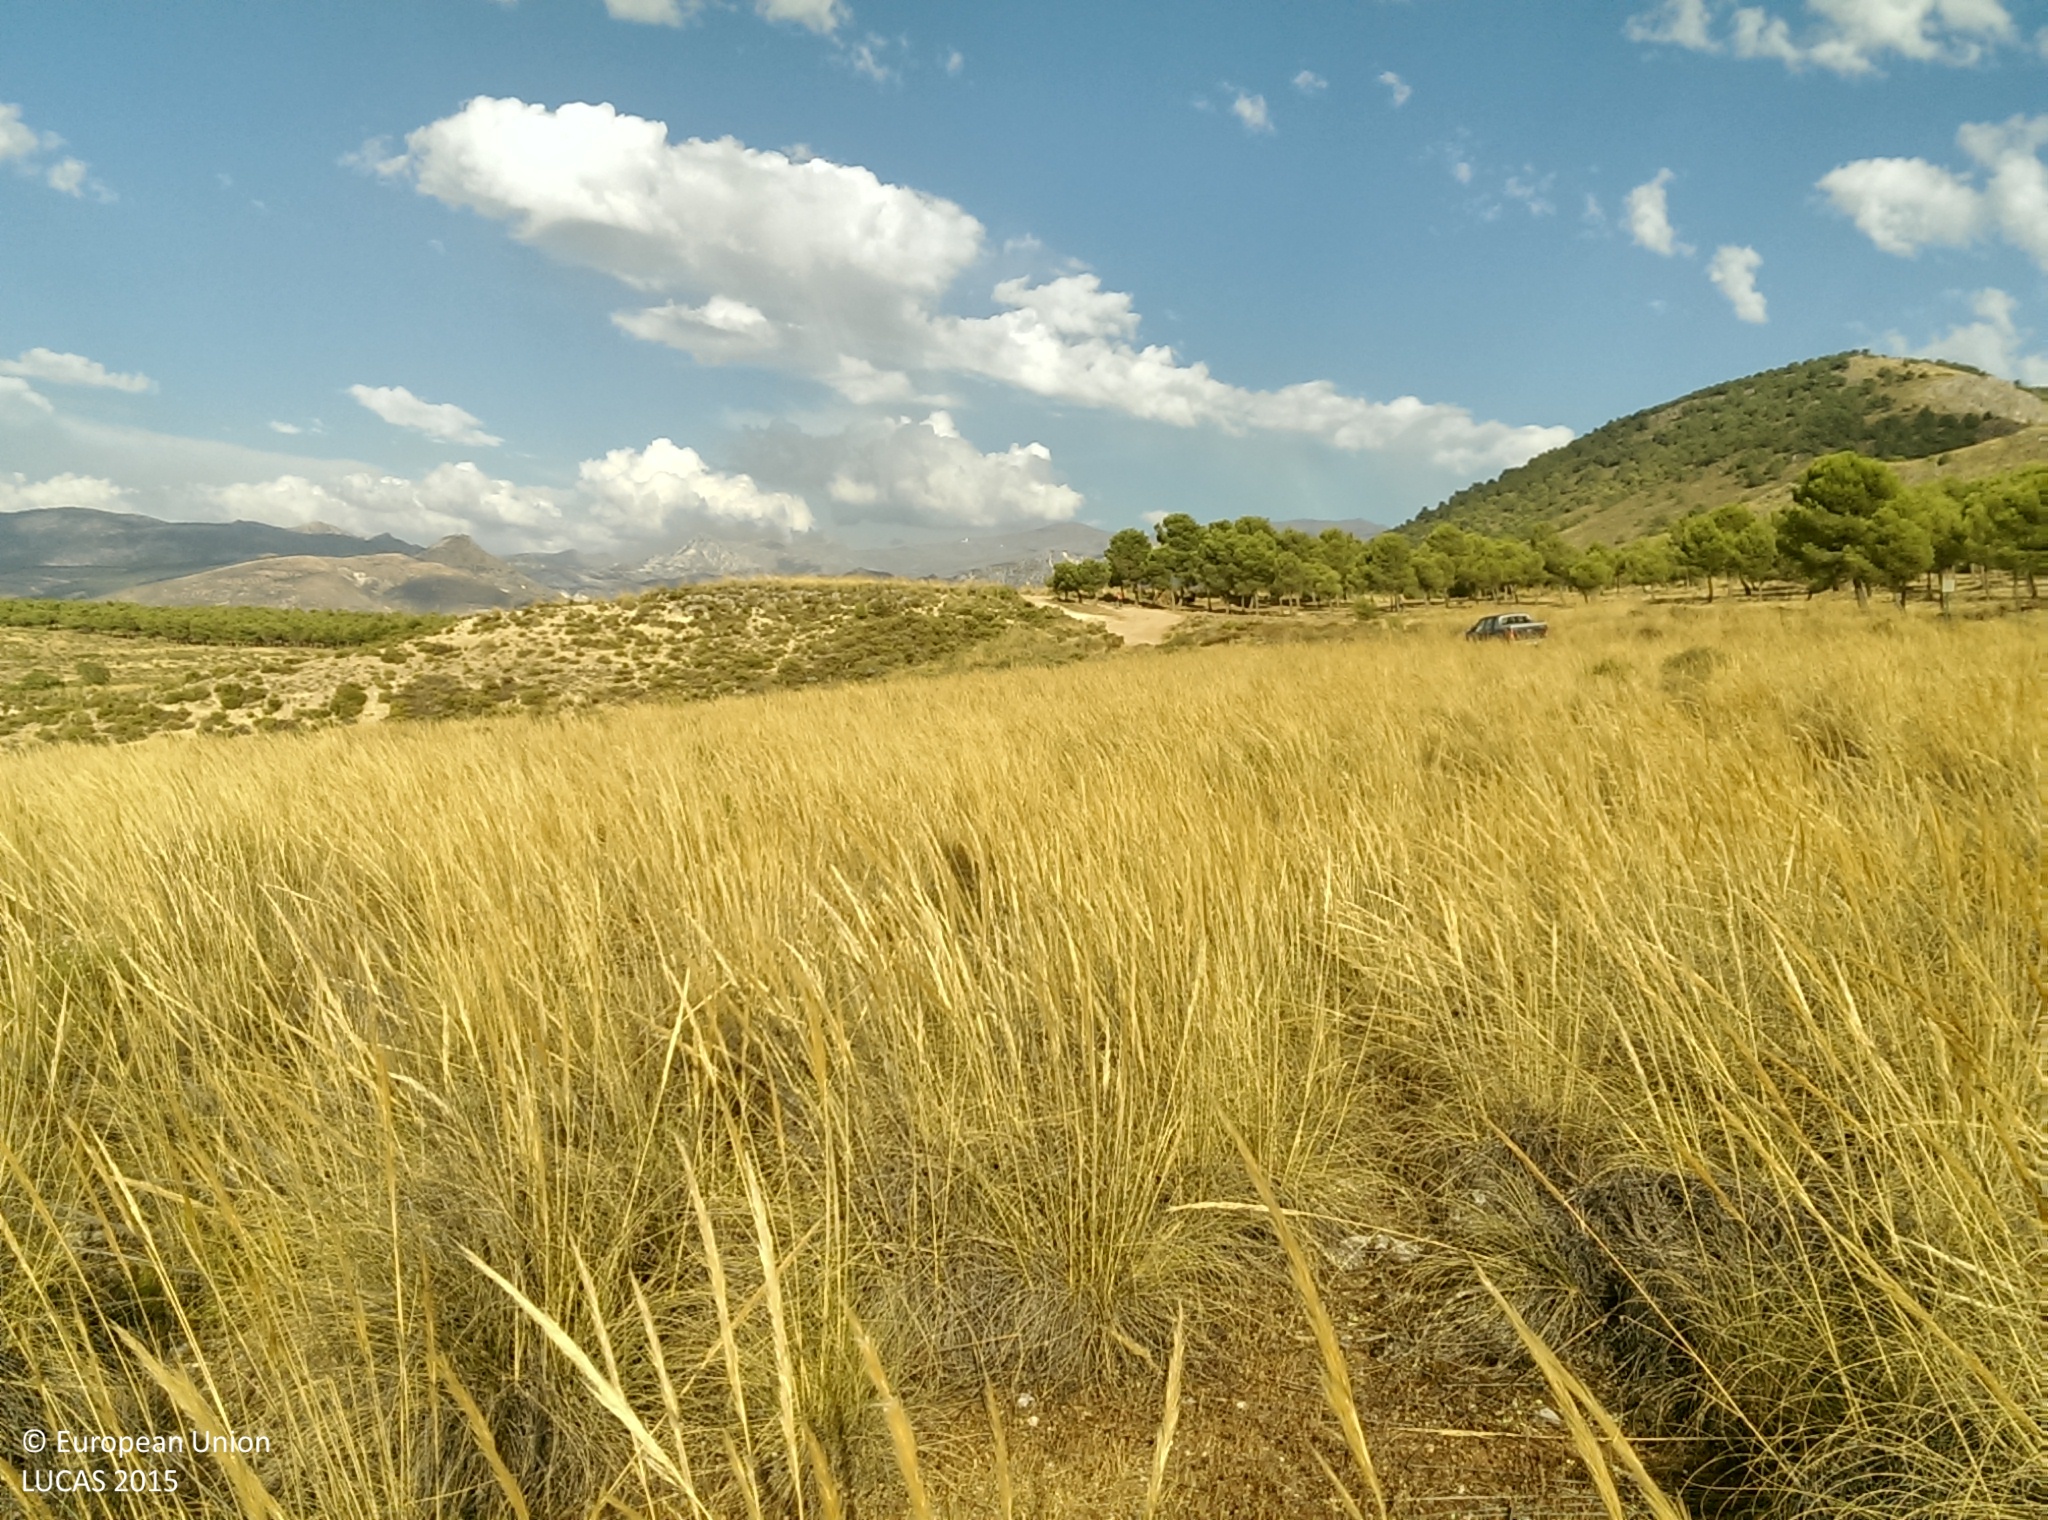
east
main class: Grassland
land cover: Grassland without tree/shrub cover
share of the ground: > 75 %
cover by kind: herbaceous plants 75 %, unconsolidated bare surface 20 %, shrubs 5 %
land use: Abandoned areas
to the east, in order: Grassland without tree/shrub cover; Tracks; Pine dominated coniferous woodland; Grassland without tree/shrub cover; Tracks; Grassland without tree/shrub cover
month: August
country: ES
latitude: 37.0553
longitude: -3.6279
